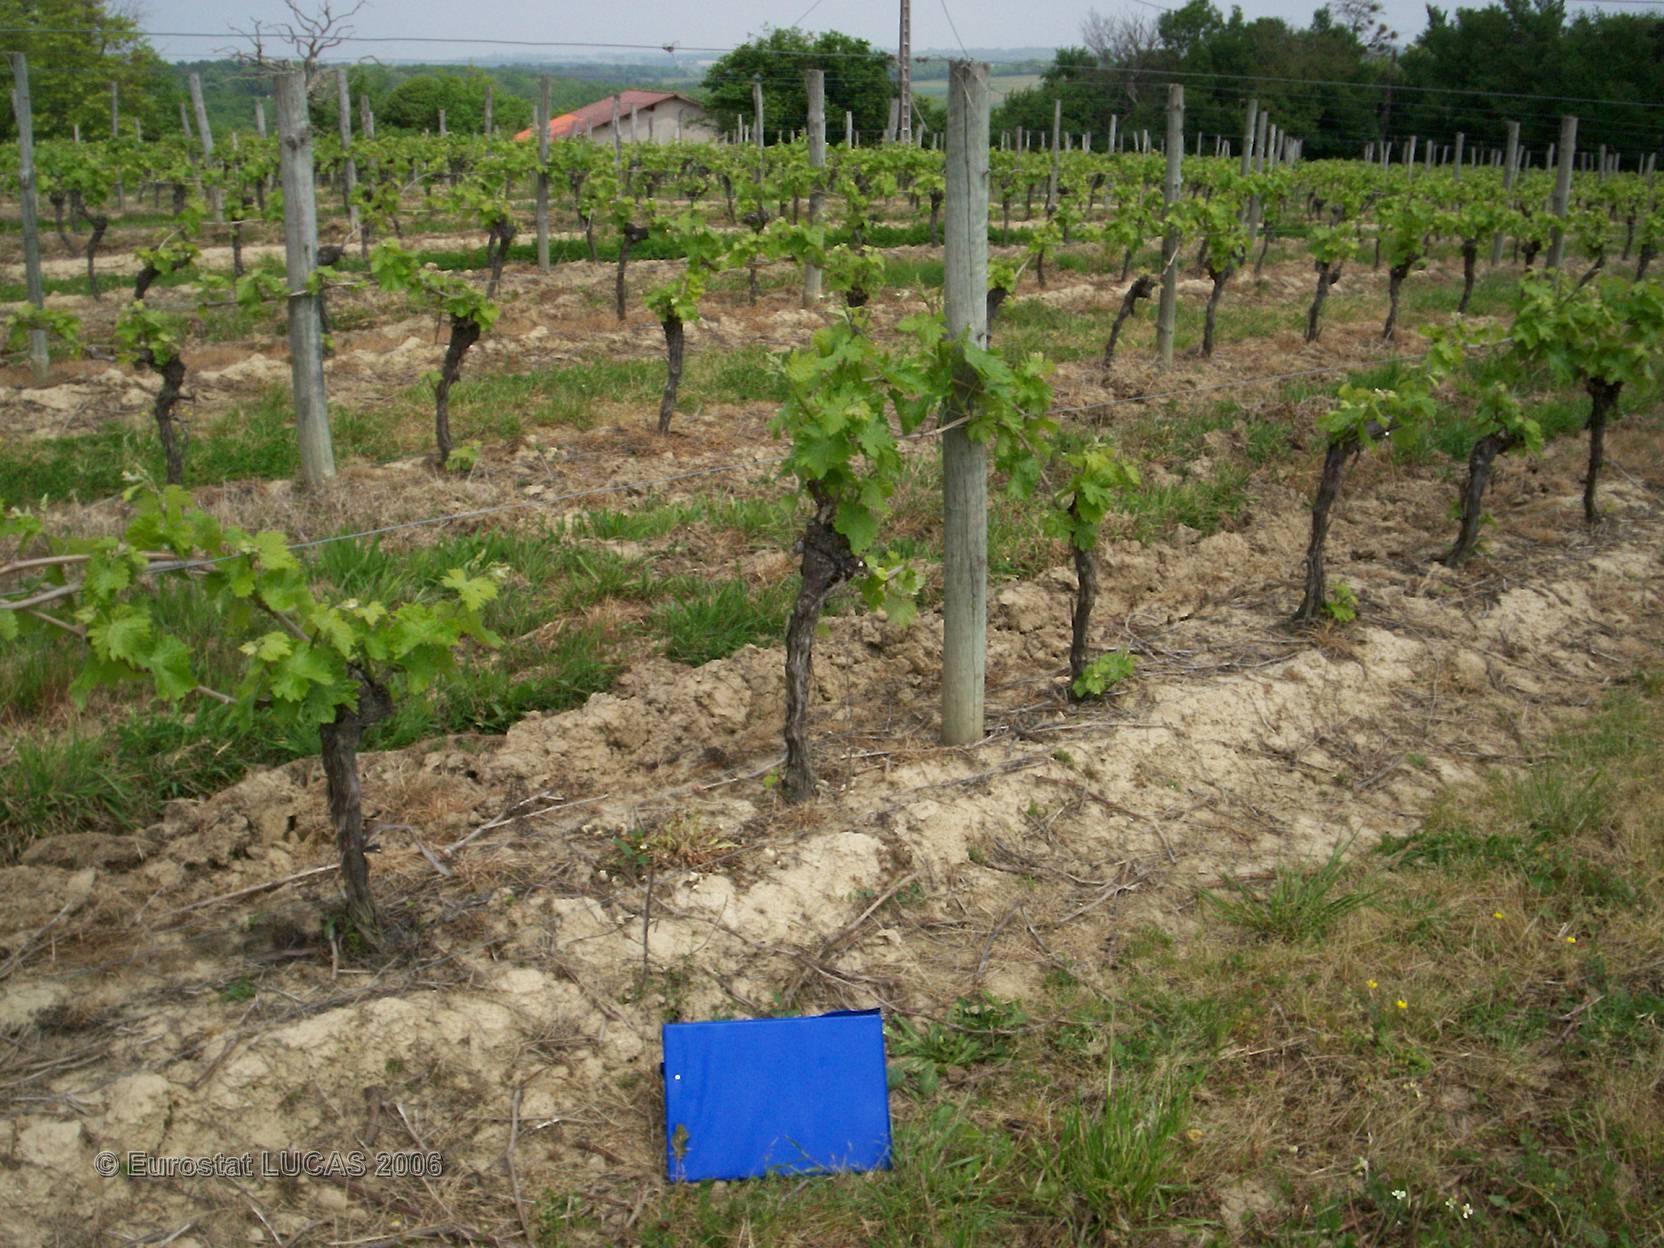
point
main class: Cropland
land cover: Vineyards
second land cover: Grassland with sparse tree/shrub cover
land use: Agriculture (excluding fallow land and kitchen gardens)
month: May
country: FR
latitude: 43.8831
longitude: 0.1732
